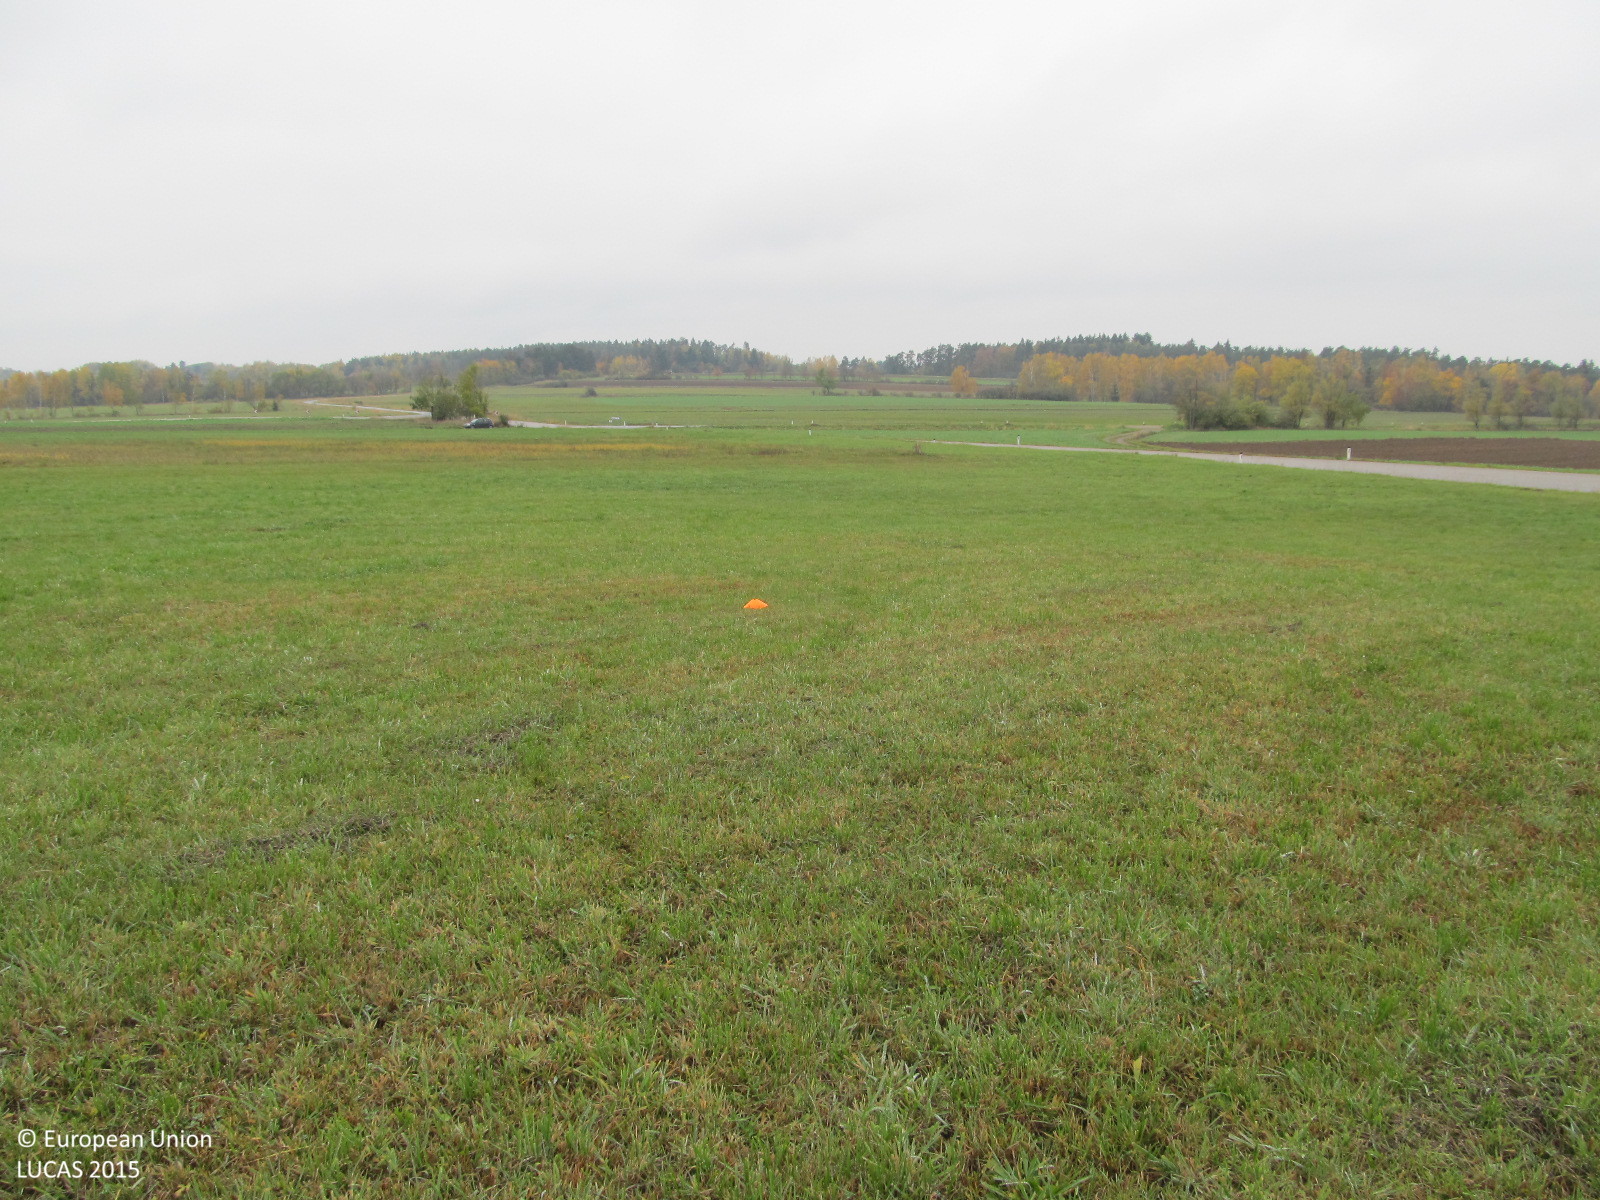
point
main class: Grassland
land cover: Grassland without tree/shrub cover
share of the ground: > 75 %
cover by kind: herbaceous plants 100 %
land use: Agriculture (excluding fallow land and kitchen gardens)
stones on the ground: < 10 %
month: October
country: AT
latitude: 48.6135
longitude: 15.4147
